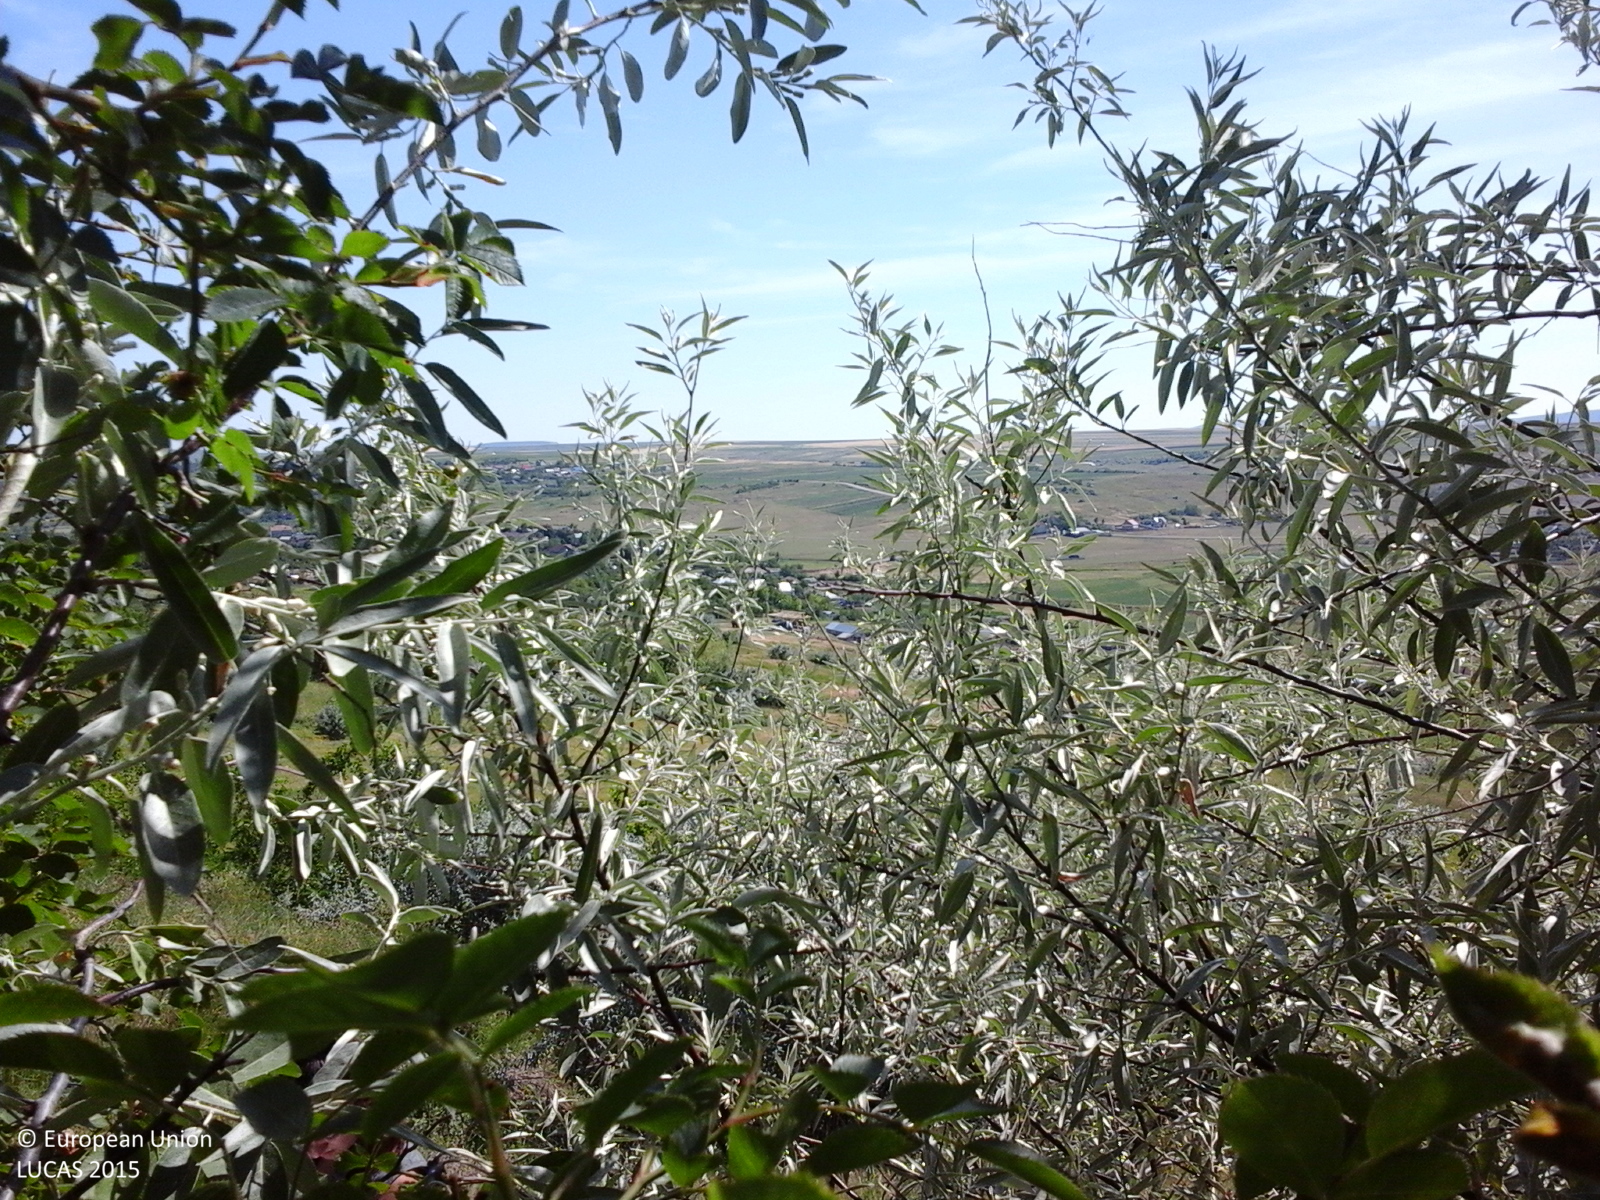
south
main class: Shrubland
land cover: Shrubland with sparse tree cover
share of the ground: > 75 %
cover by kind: shrubs 80 %, herbaceous plants 15 %, broadleaved forest trees 5 %
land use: Agriculture (excluding fallow land and kitchen gardens)
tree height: > 5 m
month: June
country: RO
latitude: 47.5141
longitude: 27.0073
